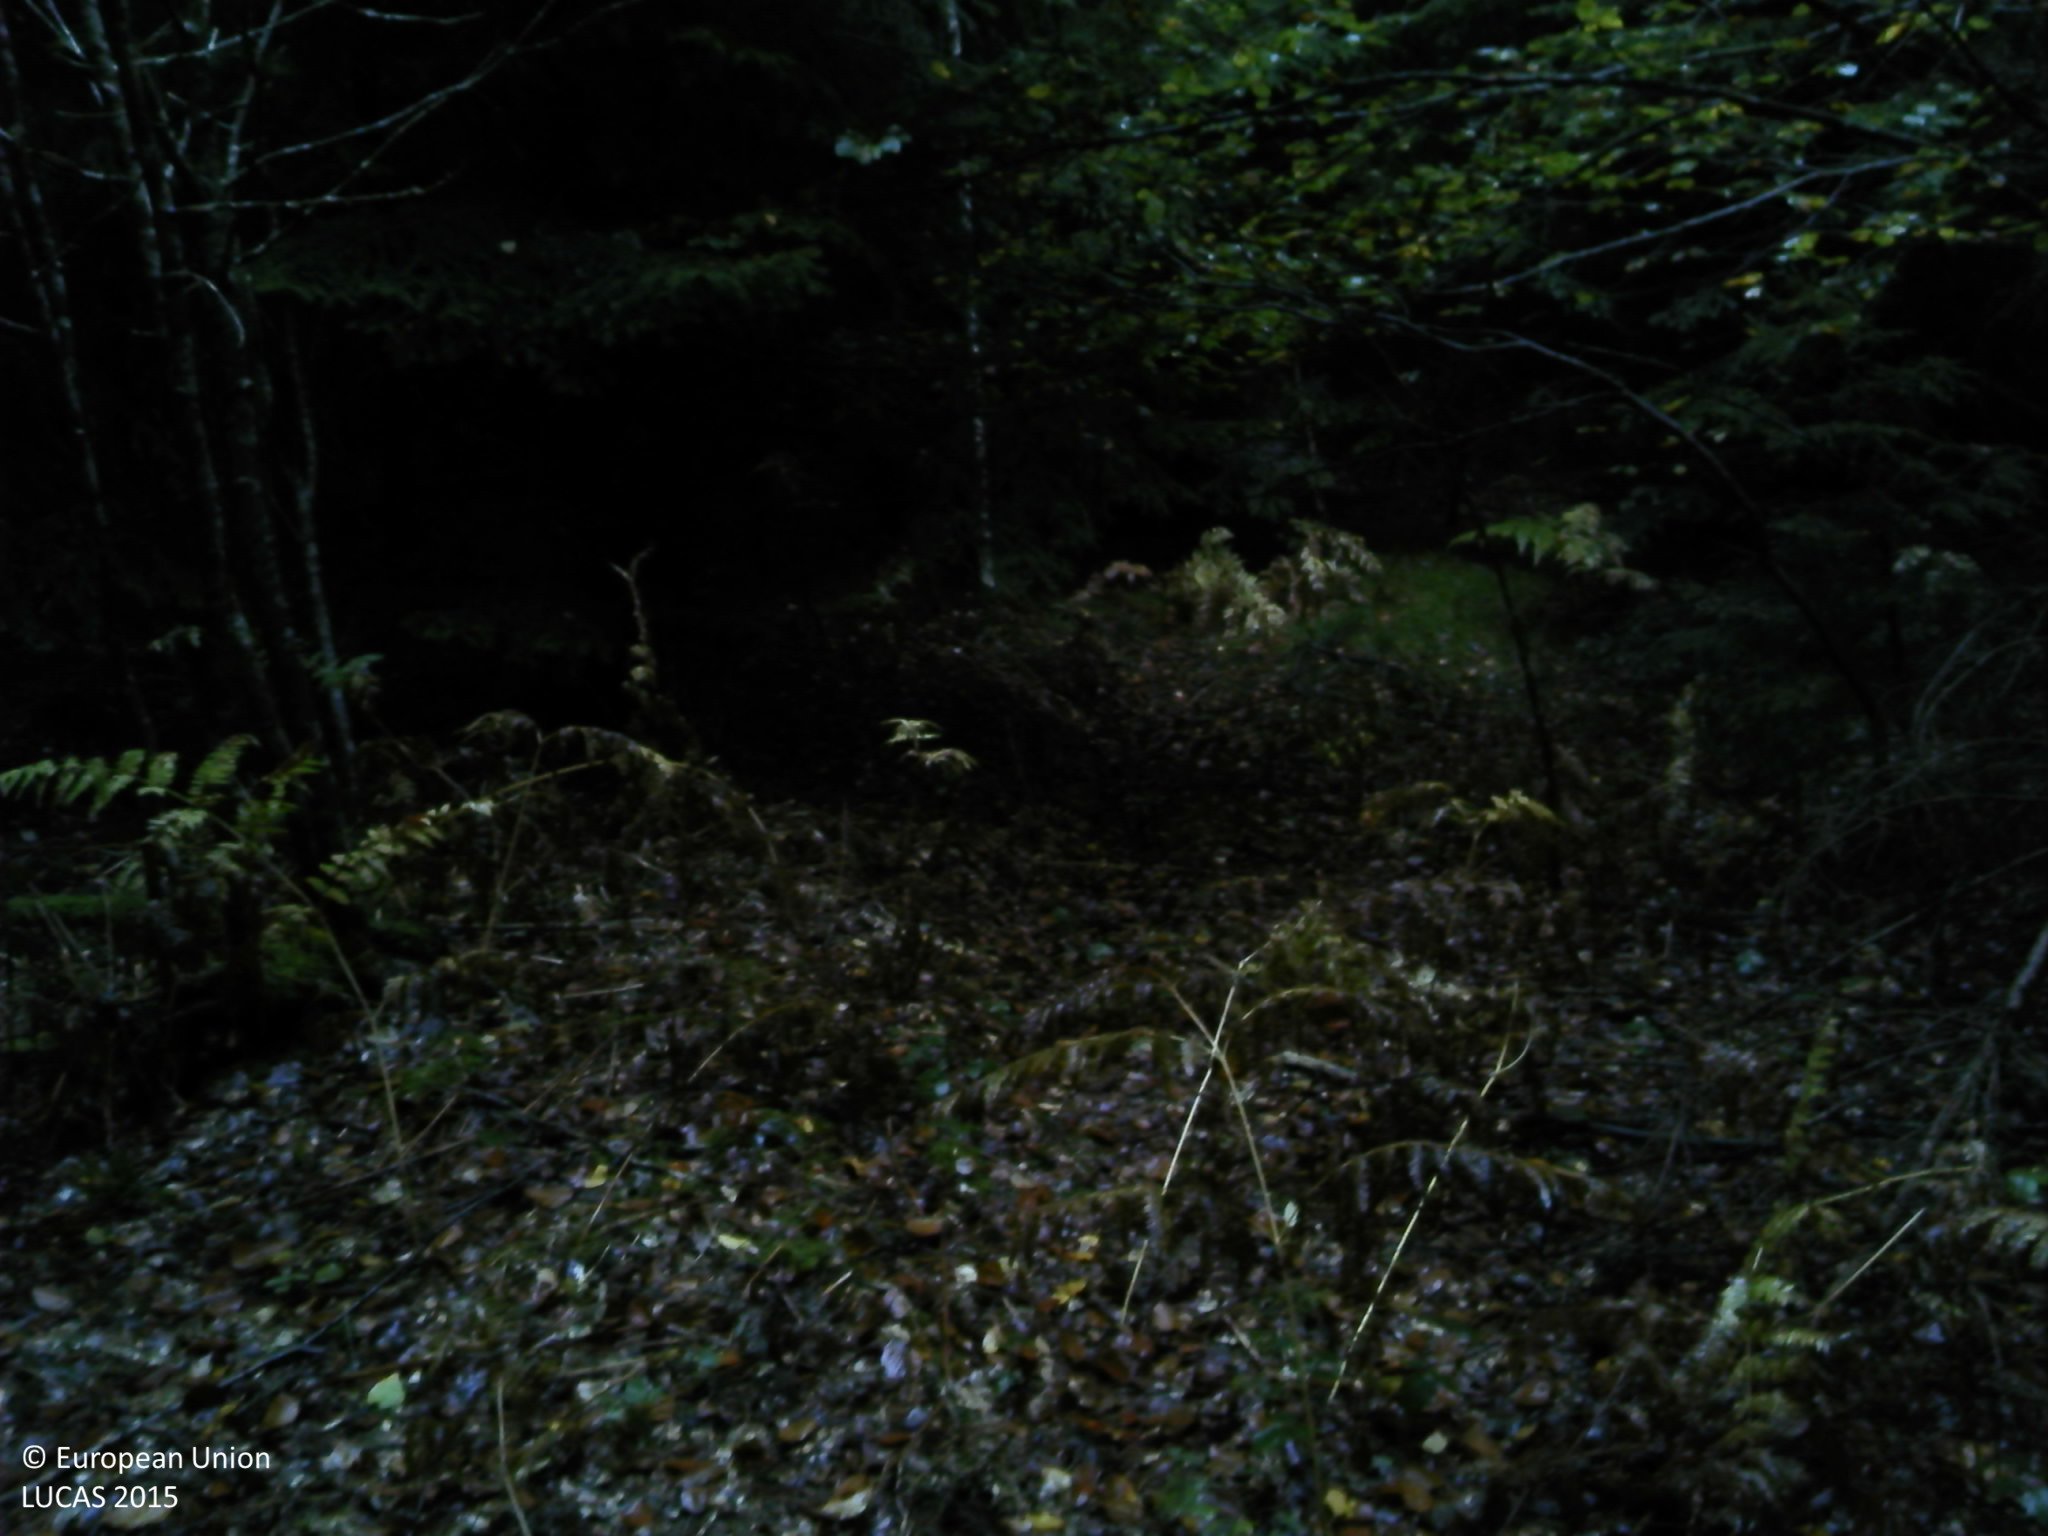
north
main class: Woodland
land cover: Spruce dominated coniferous woodland
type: alpine coniferous forest
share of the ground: > 75 %
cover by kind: coniferous forest trees 85 %, broadleaved forest trees 15 %
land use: Forestry
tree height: > 5 m
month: October
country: FR
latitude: 46.9782
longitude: 4.0177
